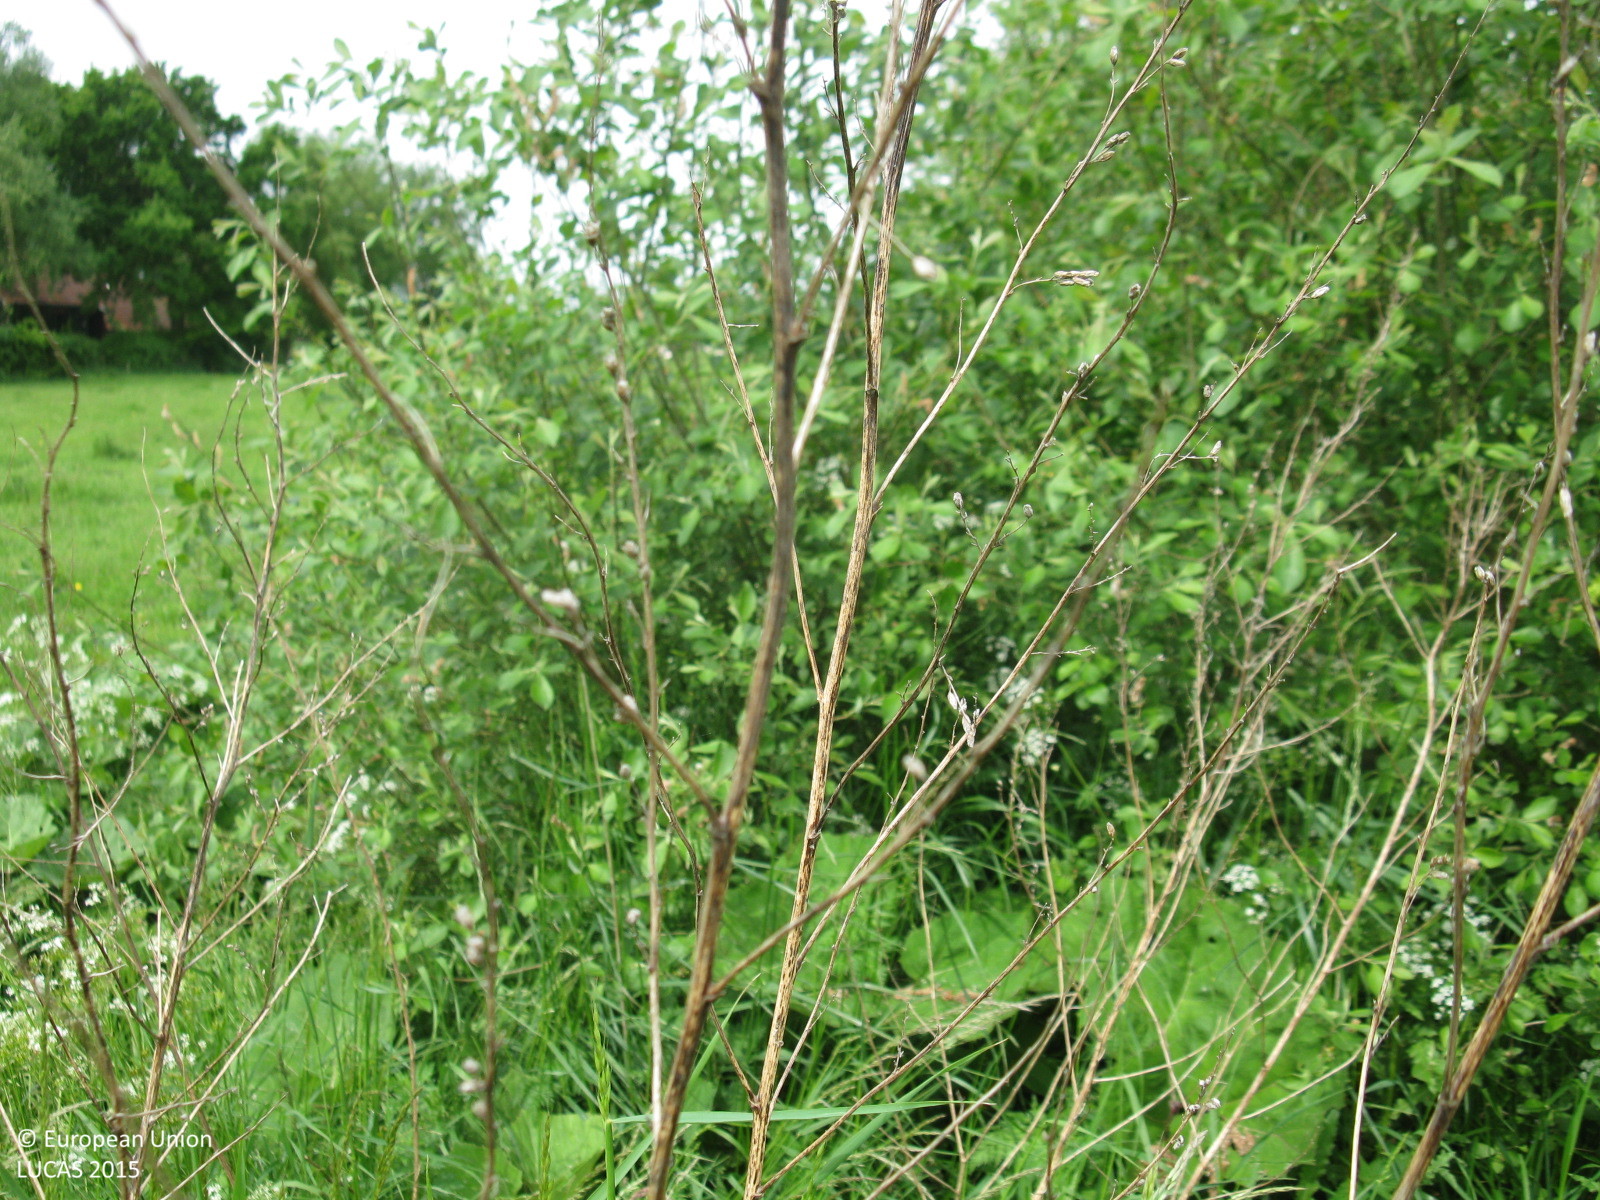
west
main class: Grassland
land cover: Grassland without tree/shrub cover
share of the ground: > 75 %
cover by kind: herbaceous plants 100 %
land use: Agriculture (excluding fallow land and kitchen gardens)
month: June
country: DE
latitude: 53.1380
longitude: 7.2949
